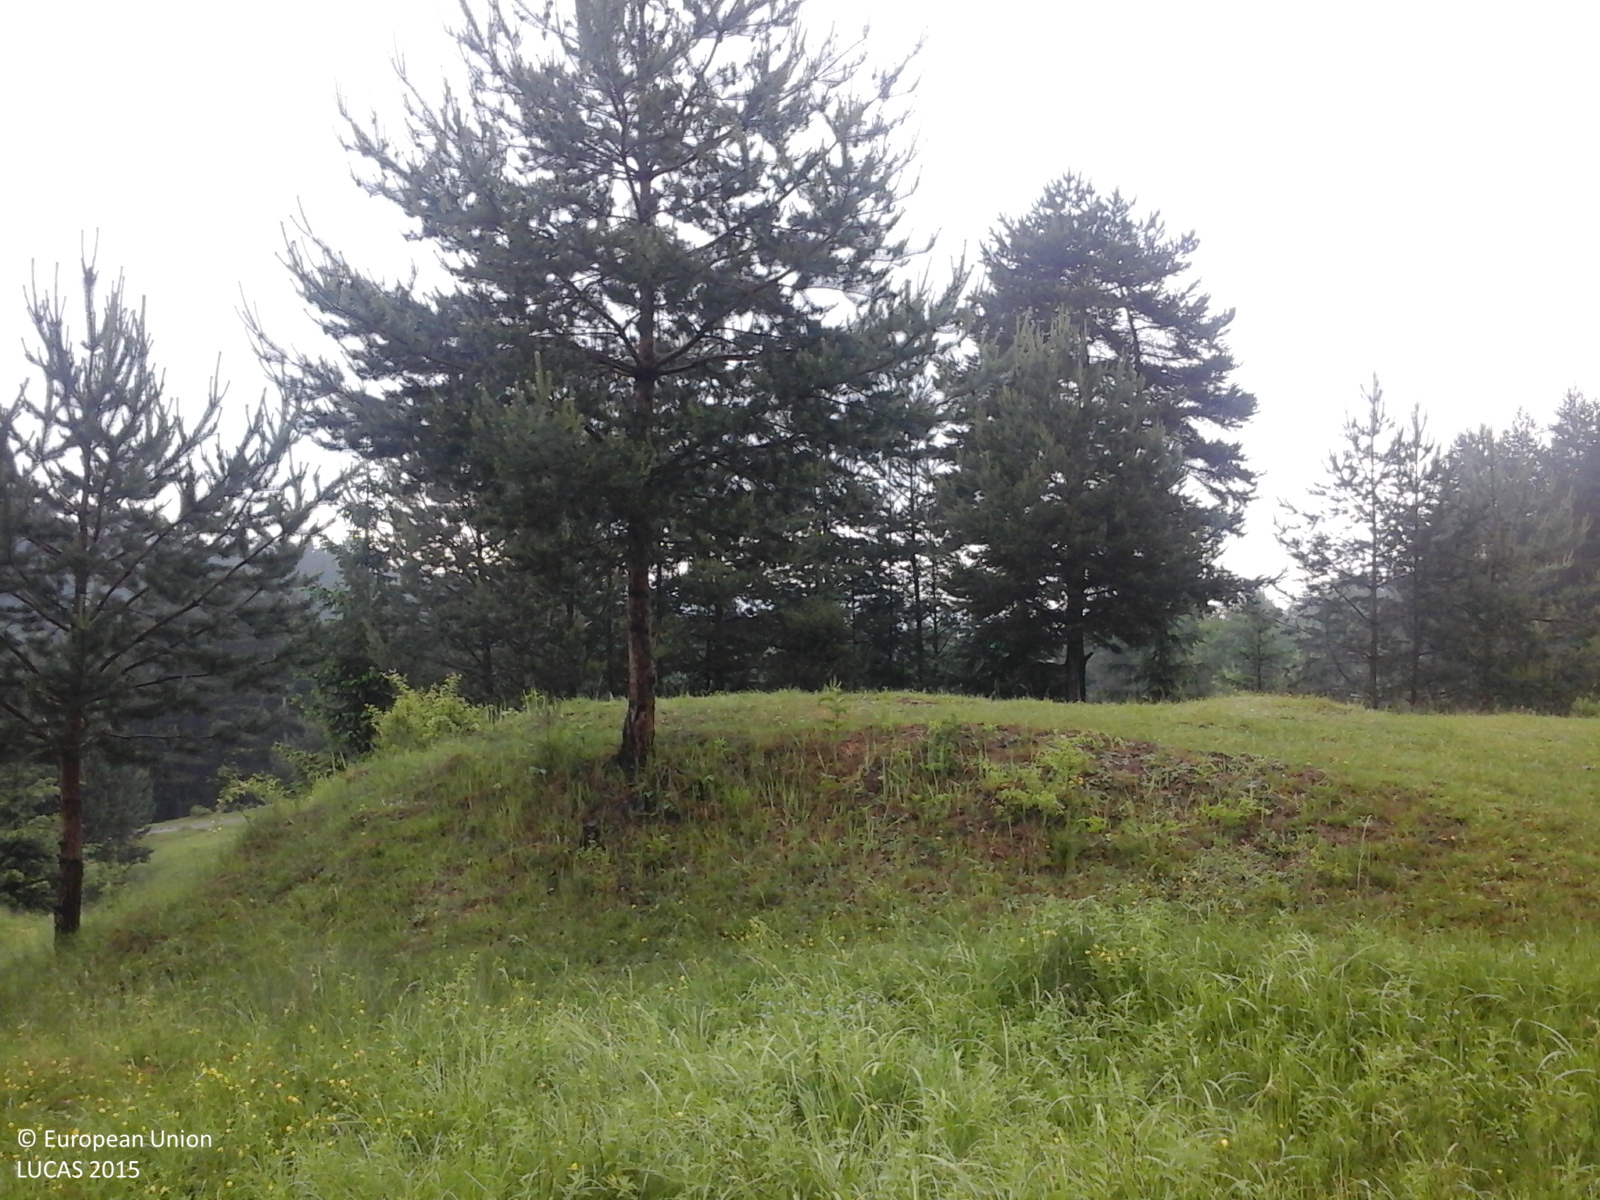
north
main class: Grassland
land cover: Grassland without tree/shrub cover
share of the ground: > 75 %
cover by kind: herbaceous plants 100 %
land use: Agriculture (excluding fallow land and kitchen gardens)
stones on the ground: < 10 %
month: June
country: RO
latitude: 46.4100
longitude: 26.4316
